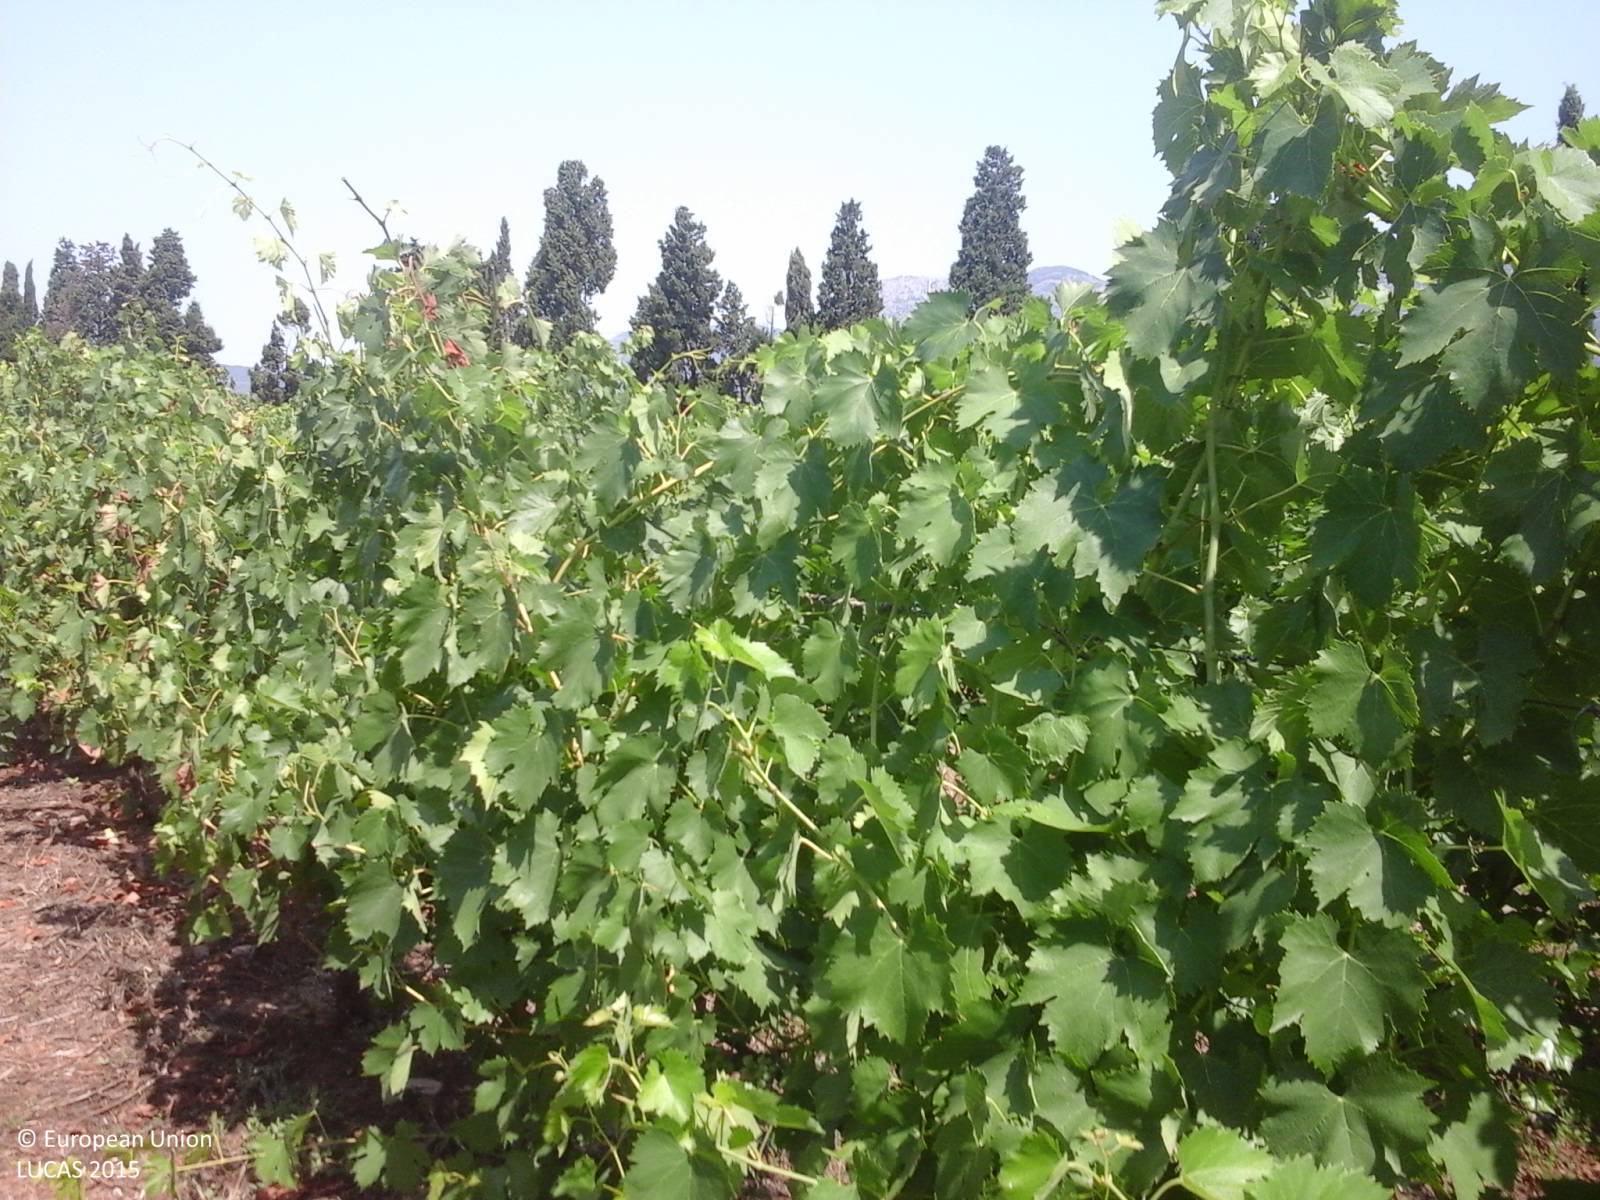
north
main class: Cropland
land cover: Vineyards
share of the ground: 25 - 50 %
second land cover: Spontaneously vegetated surfaces
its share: 50 - 75 %
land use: Agriculture (excluding fallow land and kitchen gardens)
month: July
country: IT
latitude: 39.2974
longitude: 8.6055
